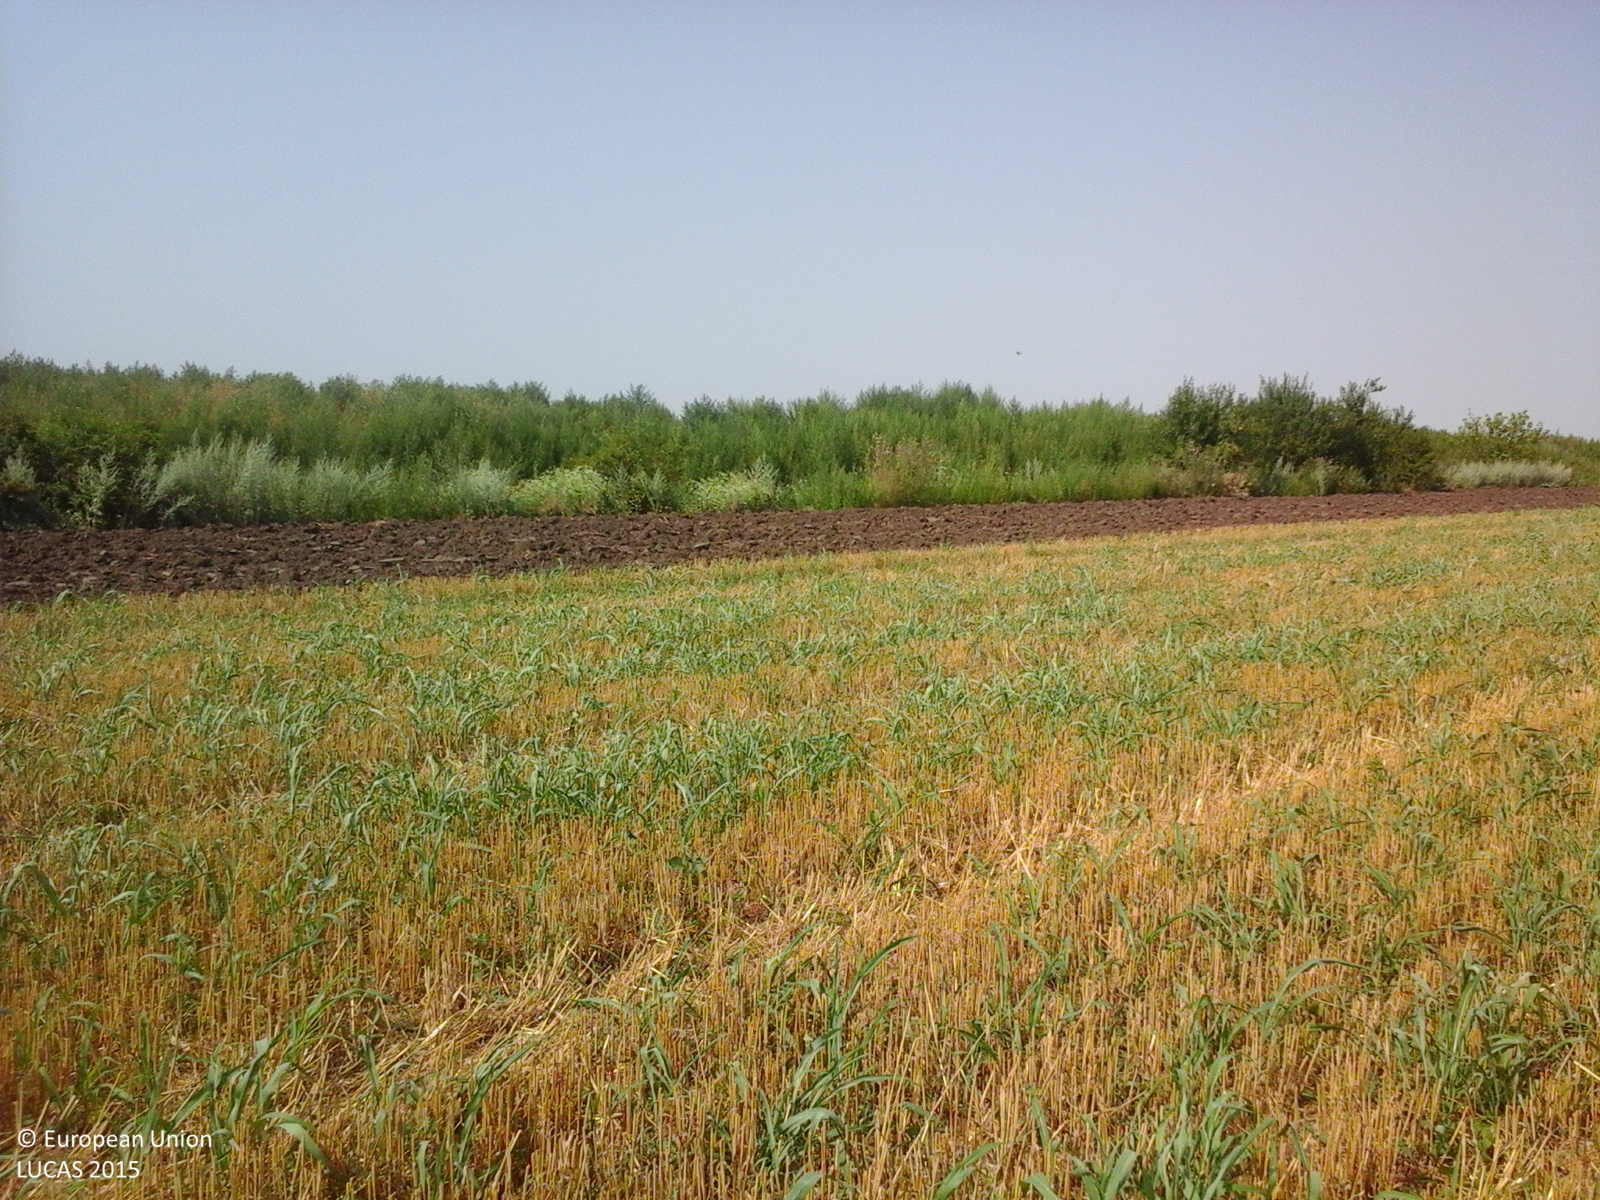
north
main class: Cropland
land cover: Durum wheat
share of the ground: 25 - 50 %
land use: Agriculture (excluding fallow land and kitchen gardens)
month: July
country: RO
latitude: 44.5375
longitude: 26.5406
